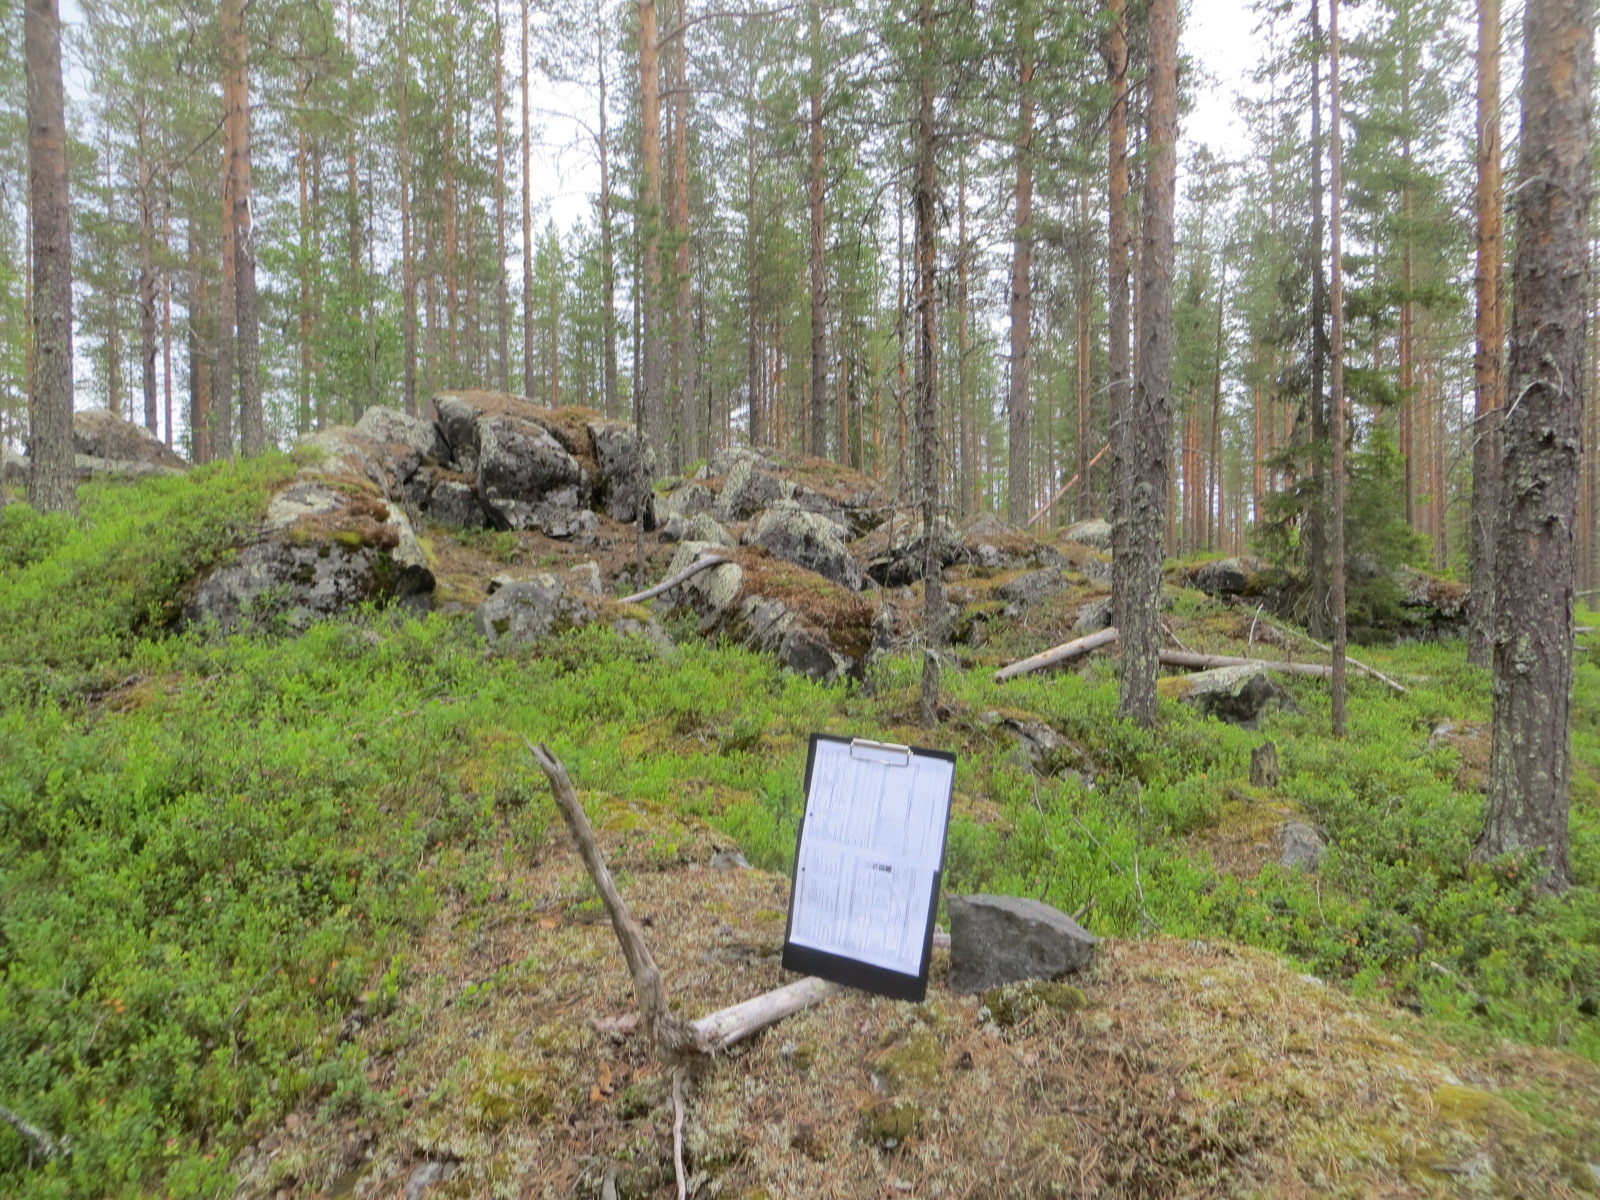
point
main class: Woodland
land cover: Pine dominated coniferous woodland
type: boreal forest
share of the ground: > 75 %
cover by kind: coniferous forest trees 75 %, shrubs 20 %, lichens and mosses 5 %
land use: Forestry
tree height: > 5 m
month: June
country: FI
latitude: 65.6194
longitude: 26.8923
